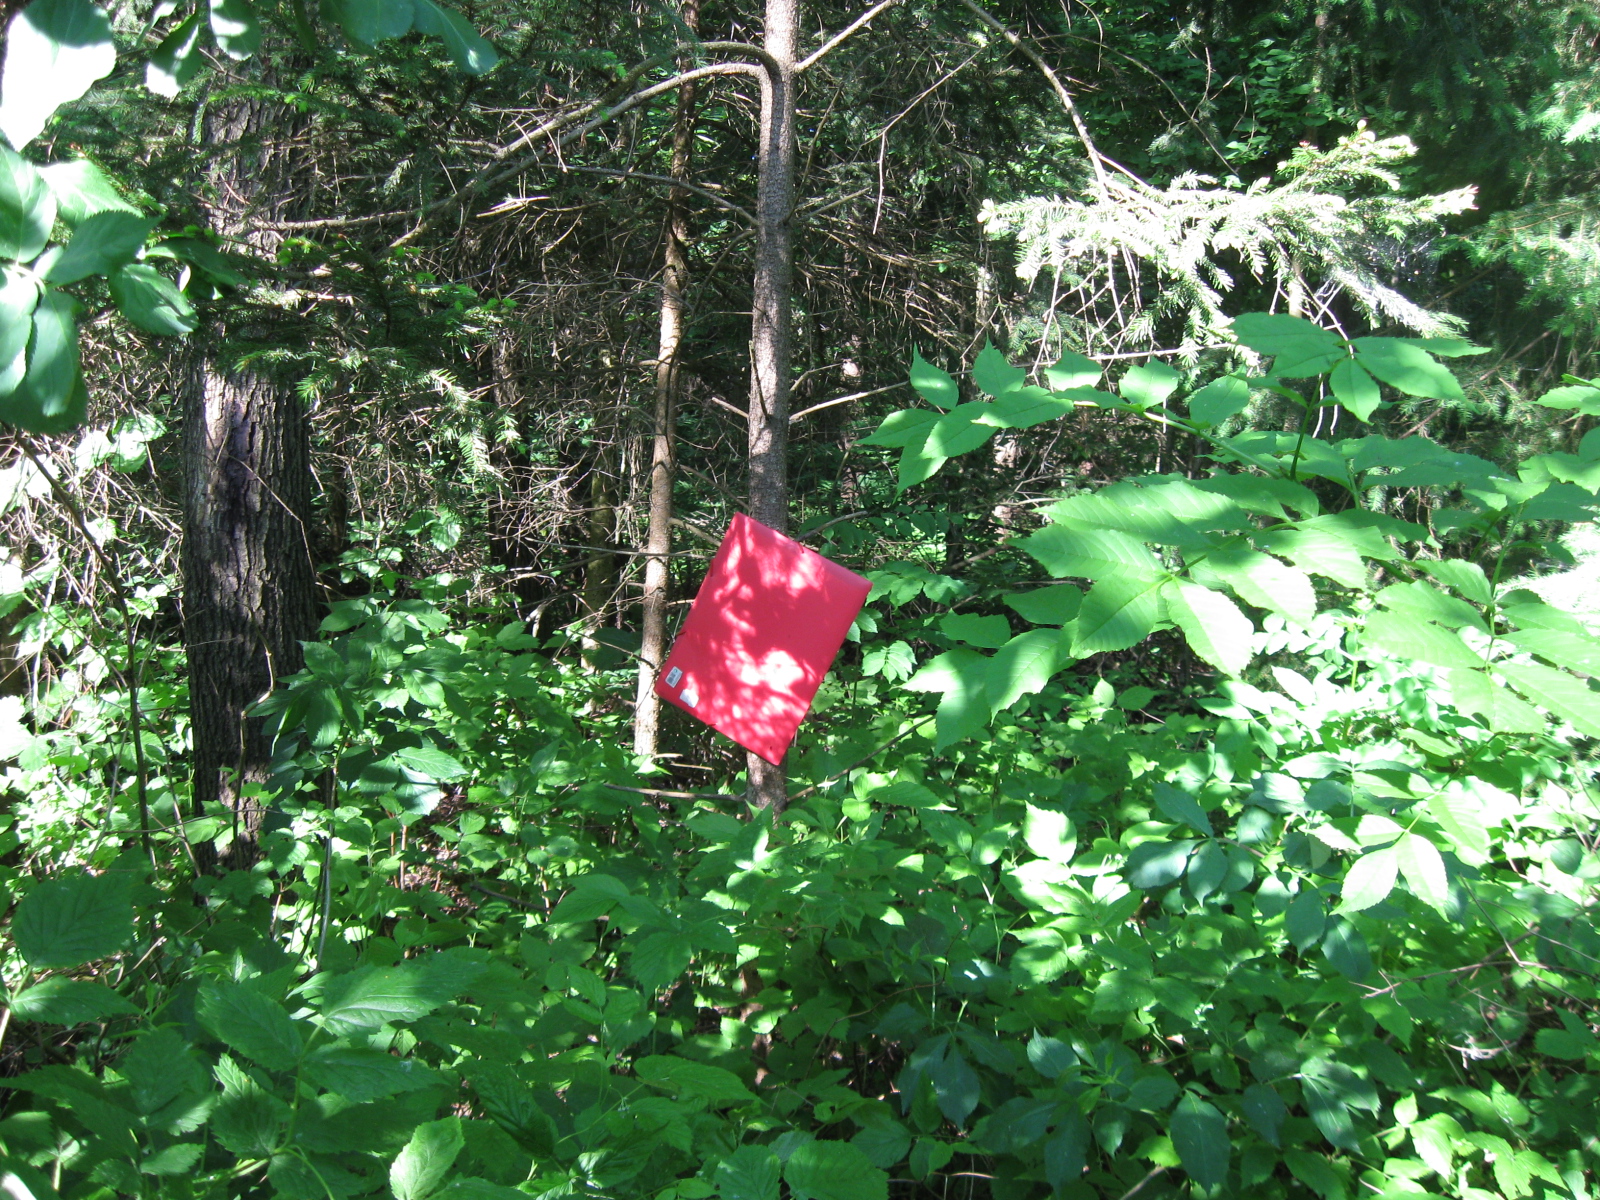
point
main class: Woodland
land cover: Spruce dominated mixed woodland
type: hemiboreal forest and nemoral coniferous forest and mixed broadleaved-coniferous forest
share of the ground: > 75 %
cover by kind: broadleaved forest trees 60 %, coniferous forest trees 30 %, herbaceous plants 10 %
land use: Forestry
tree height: > 5 m
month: June
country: LT
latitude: 54.2885
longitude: 23.6187
